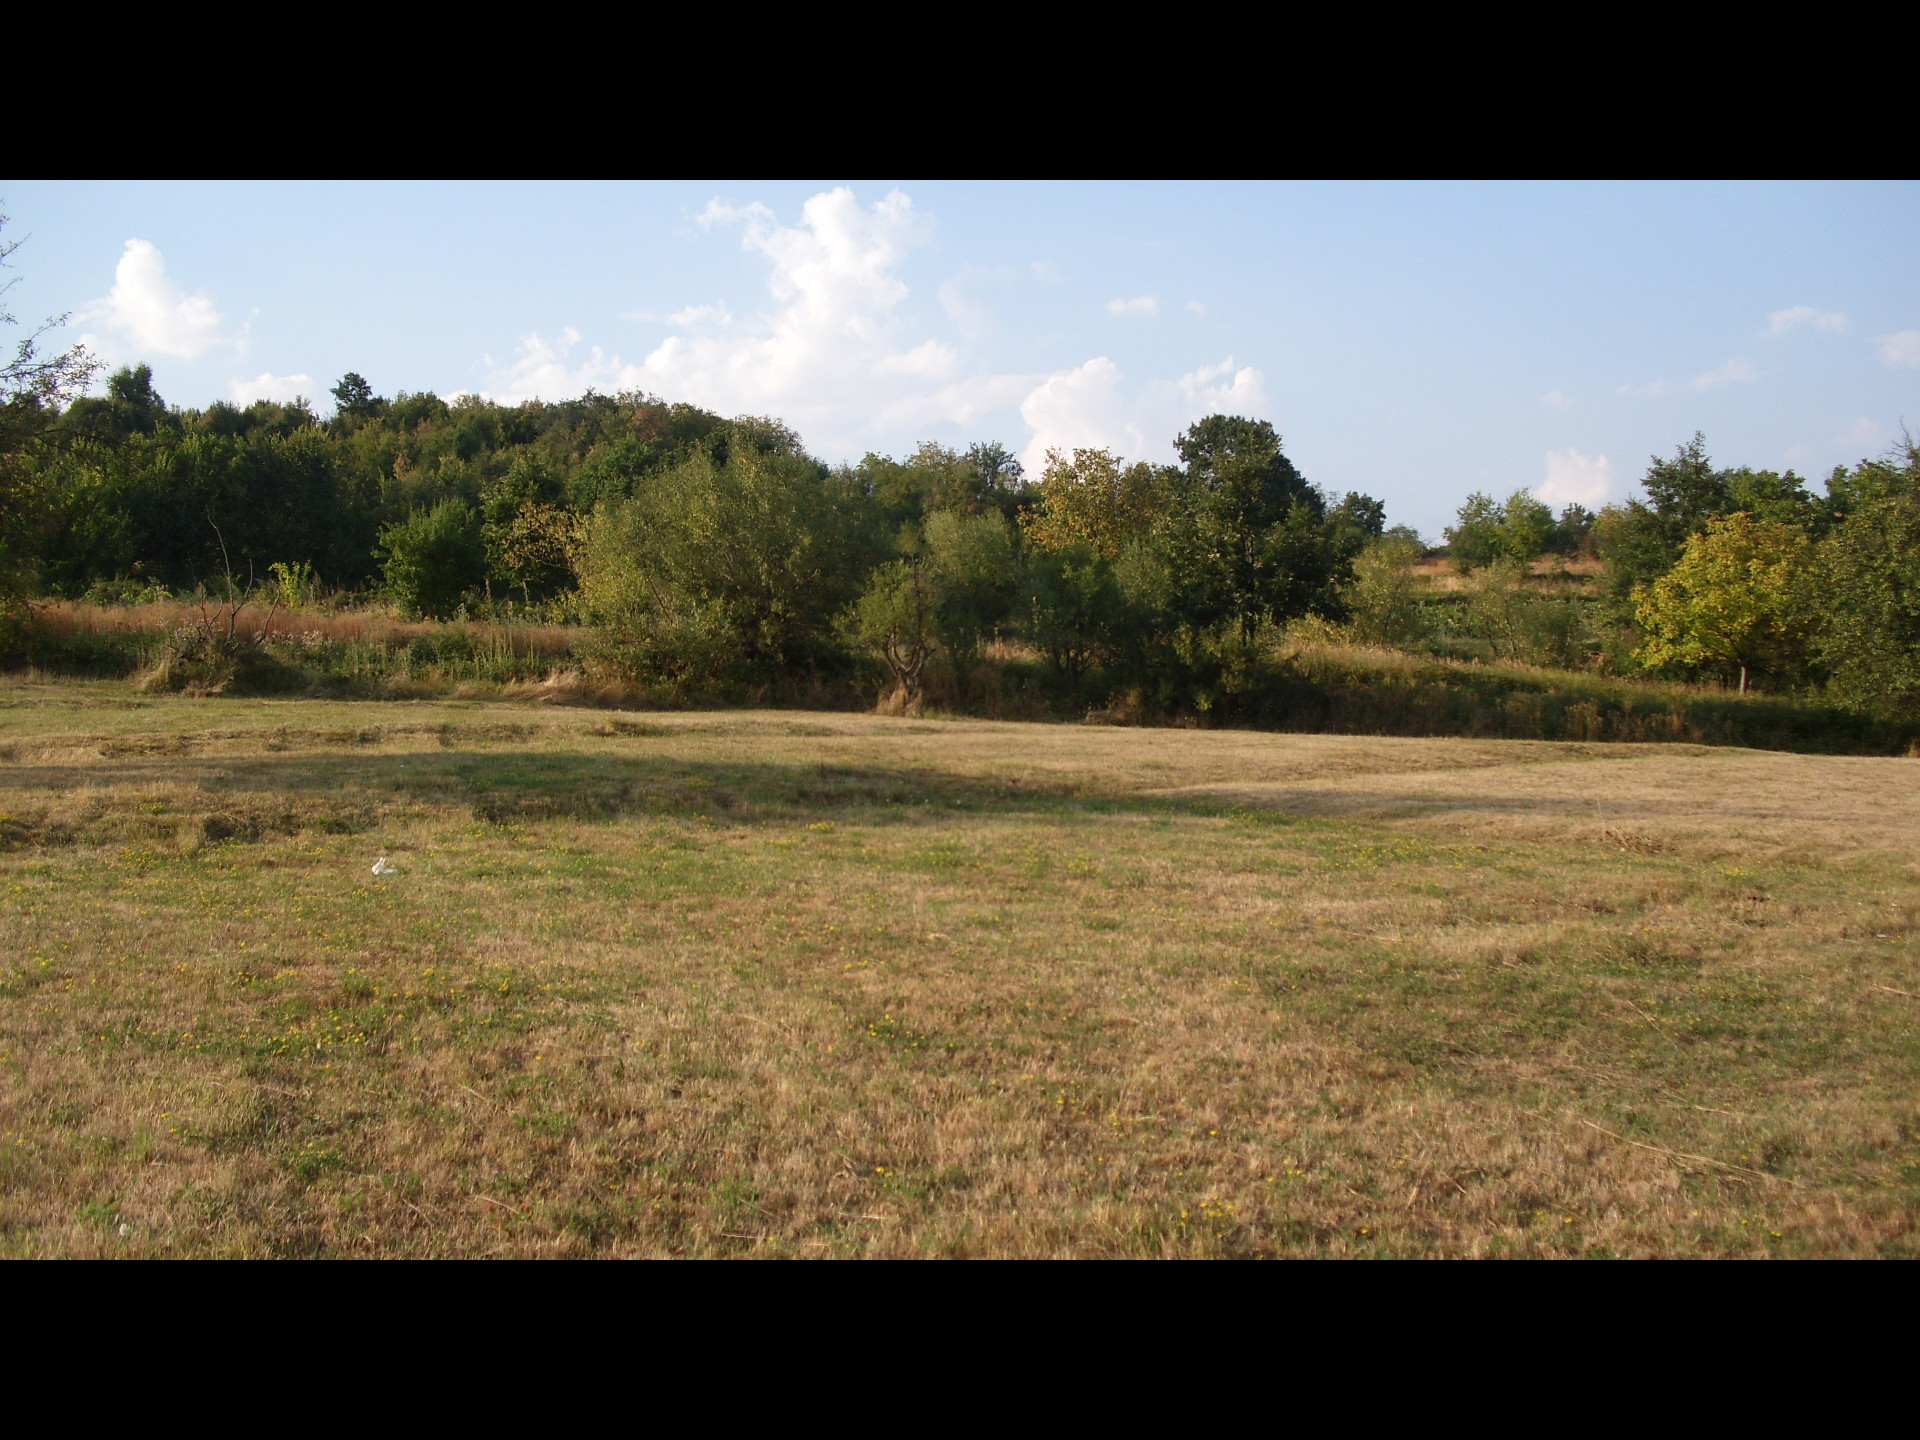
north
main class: Grassland
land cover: Grassland without tree/shrub cover
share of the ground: > 75 %
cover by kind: herbaceous plants 100 %
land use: Agriculture (excluding fallow land and kitchen gardens)
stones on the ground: < 10 %
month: August
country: BG
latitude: 43.2406
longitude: 23.2524
